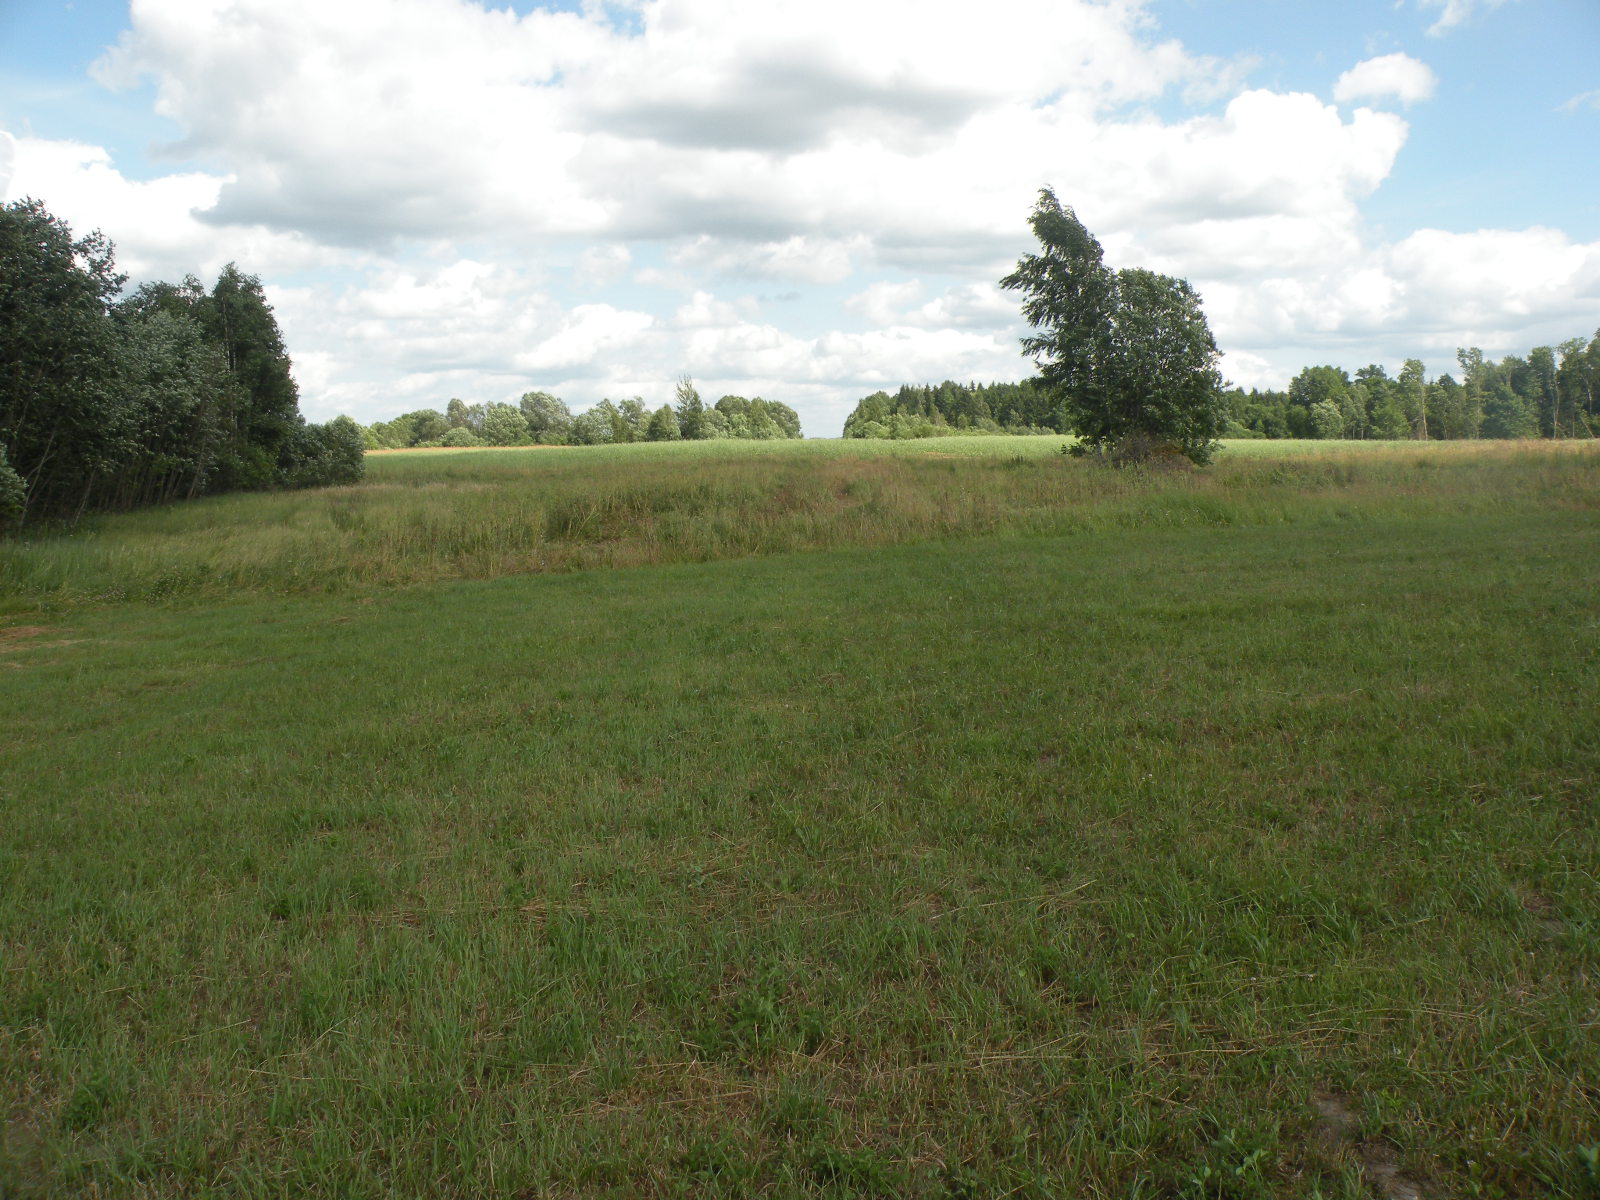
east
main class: Grassland
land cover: Grassland without tree/shrub cover
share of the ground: > 75 %
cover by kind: herbaceous plants 75 %, unconsolidated bare surface 25 %
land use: Agriculture (excluding fallow land and kitchen gardens)
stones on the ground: < 10 %
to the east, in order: Grassland without tree/shrub cover; Tracks; Grassland without tree/shrub cover; Spontaneously vegetated surfaces
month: July
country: LV
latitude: 55.8335
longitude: 26.5824
